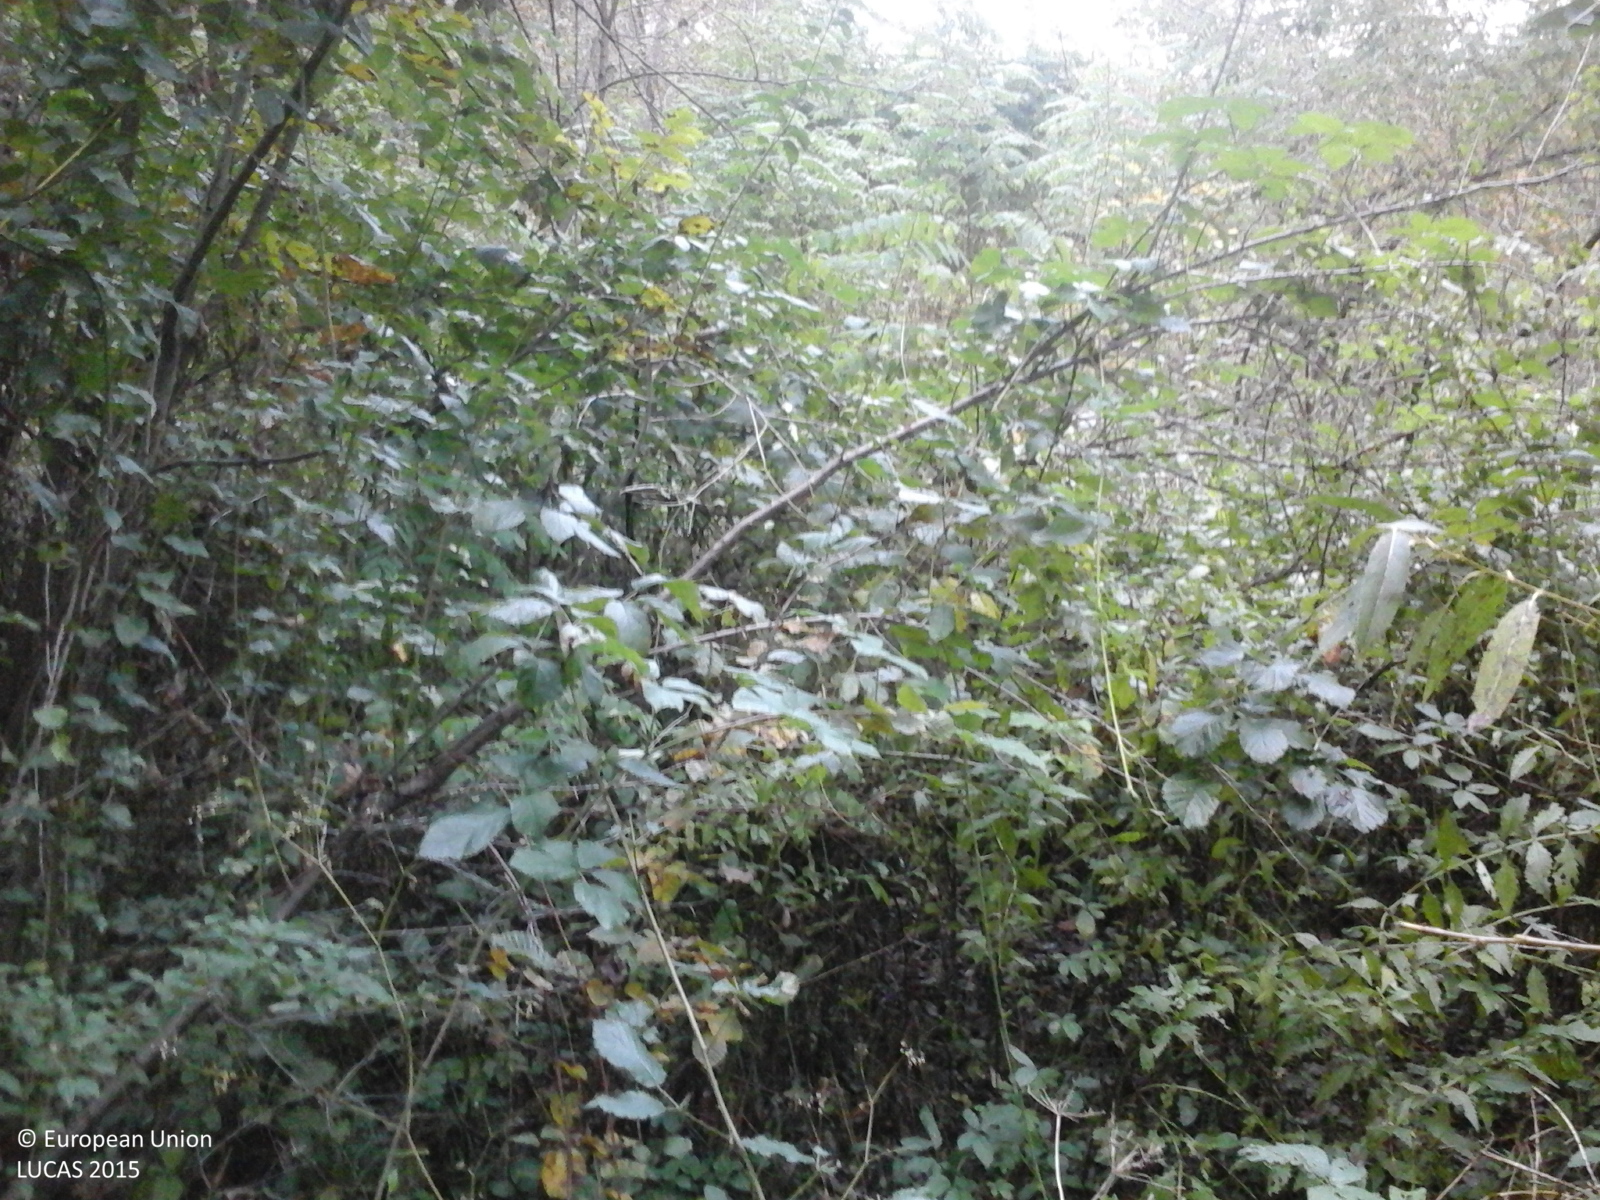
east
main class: Woodland
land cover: Broadleaved woodland
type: beech forest
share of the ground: > 75 %
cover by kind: broadleaved forest trees 100 %
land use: Forestry
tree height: > 5 m
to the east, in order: Broadleaved woodland; Grassland with sparse tree/shrub cover; Broadleaved woodland; Ditches and canals; Broadleaved woodland
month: October
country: RO
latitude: 45.1709
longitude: 25.8975
